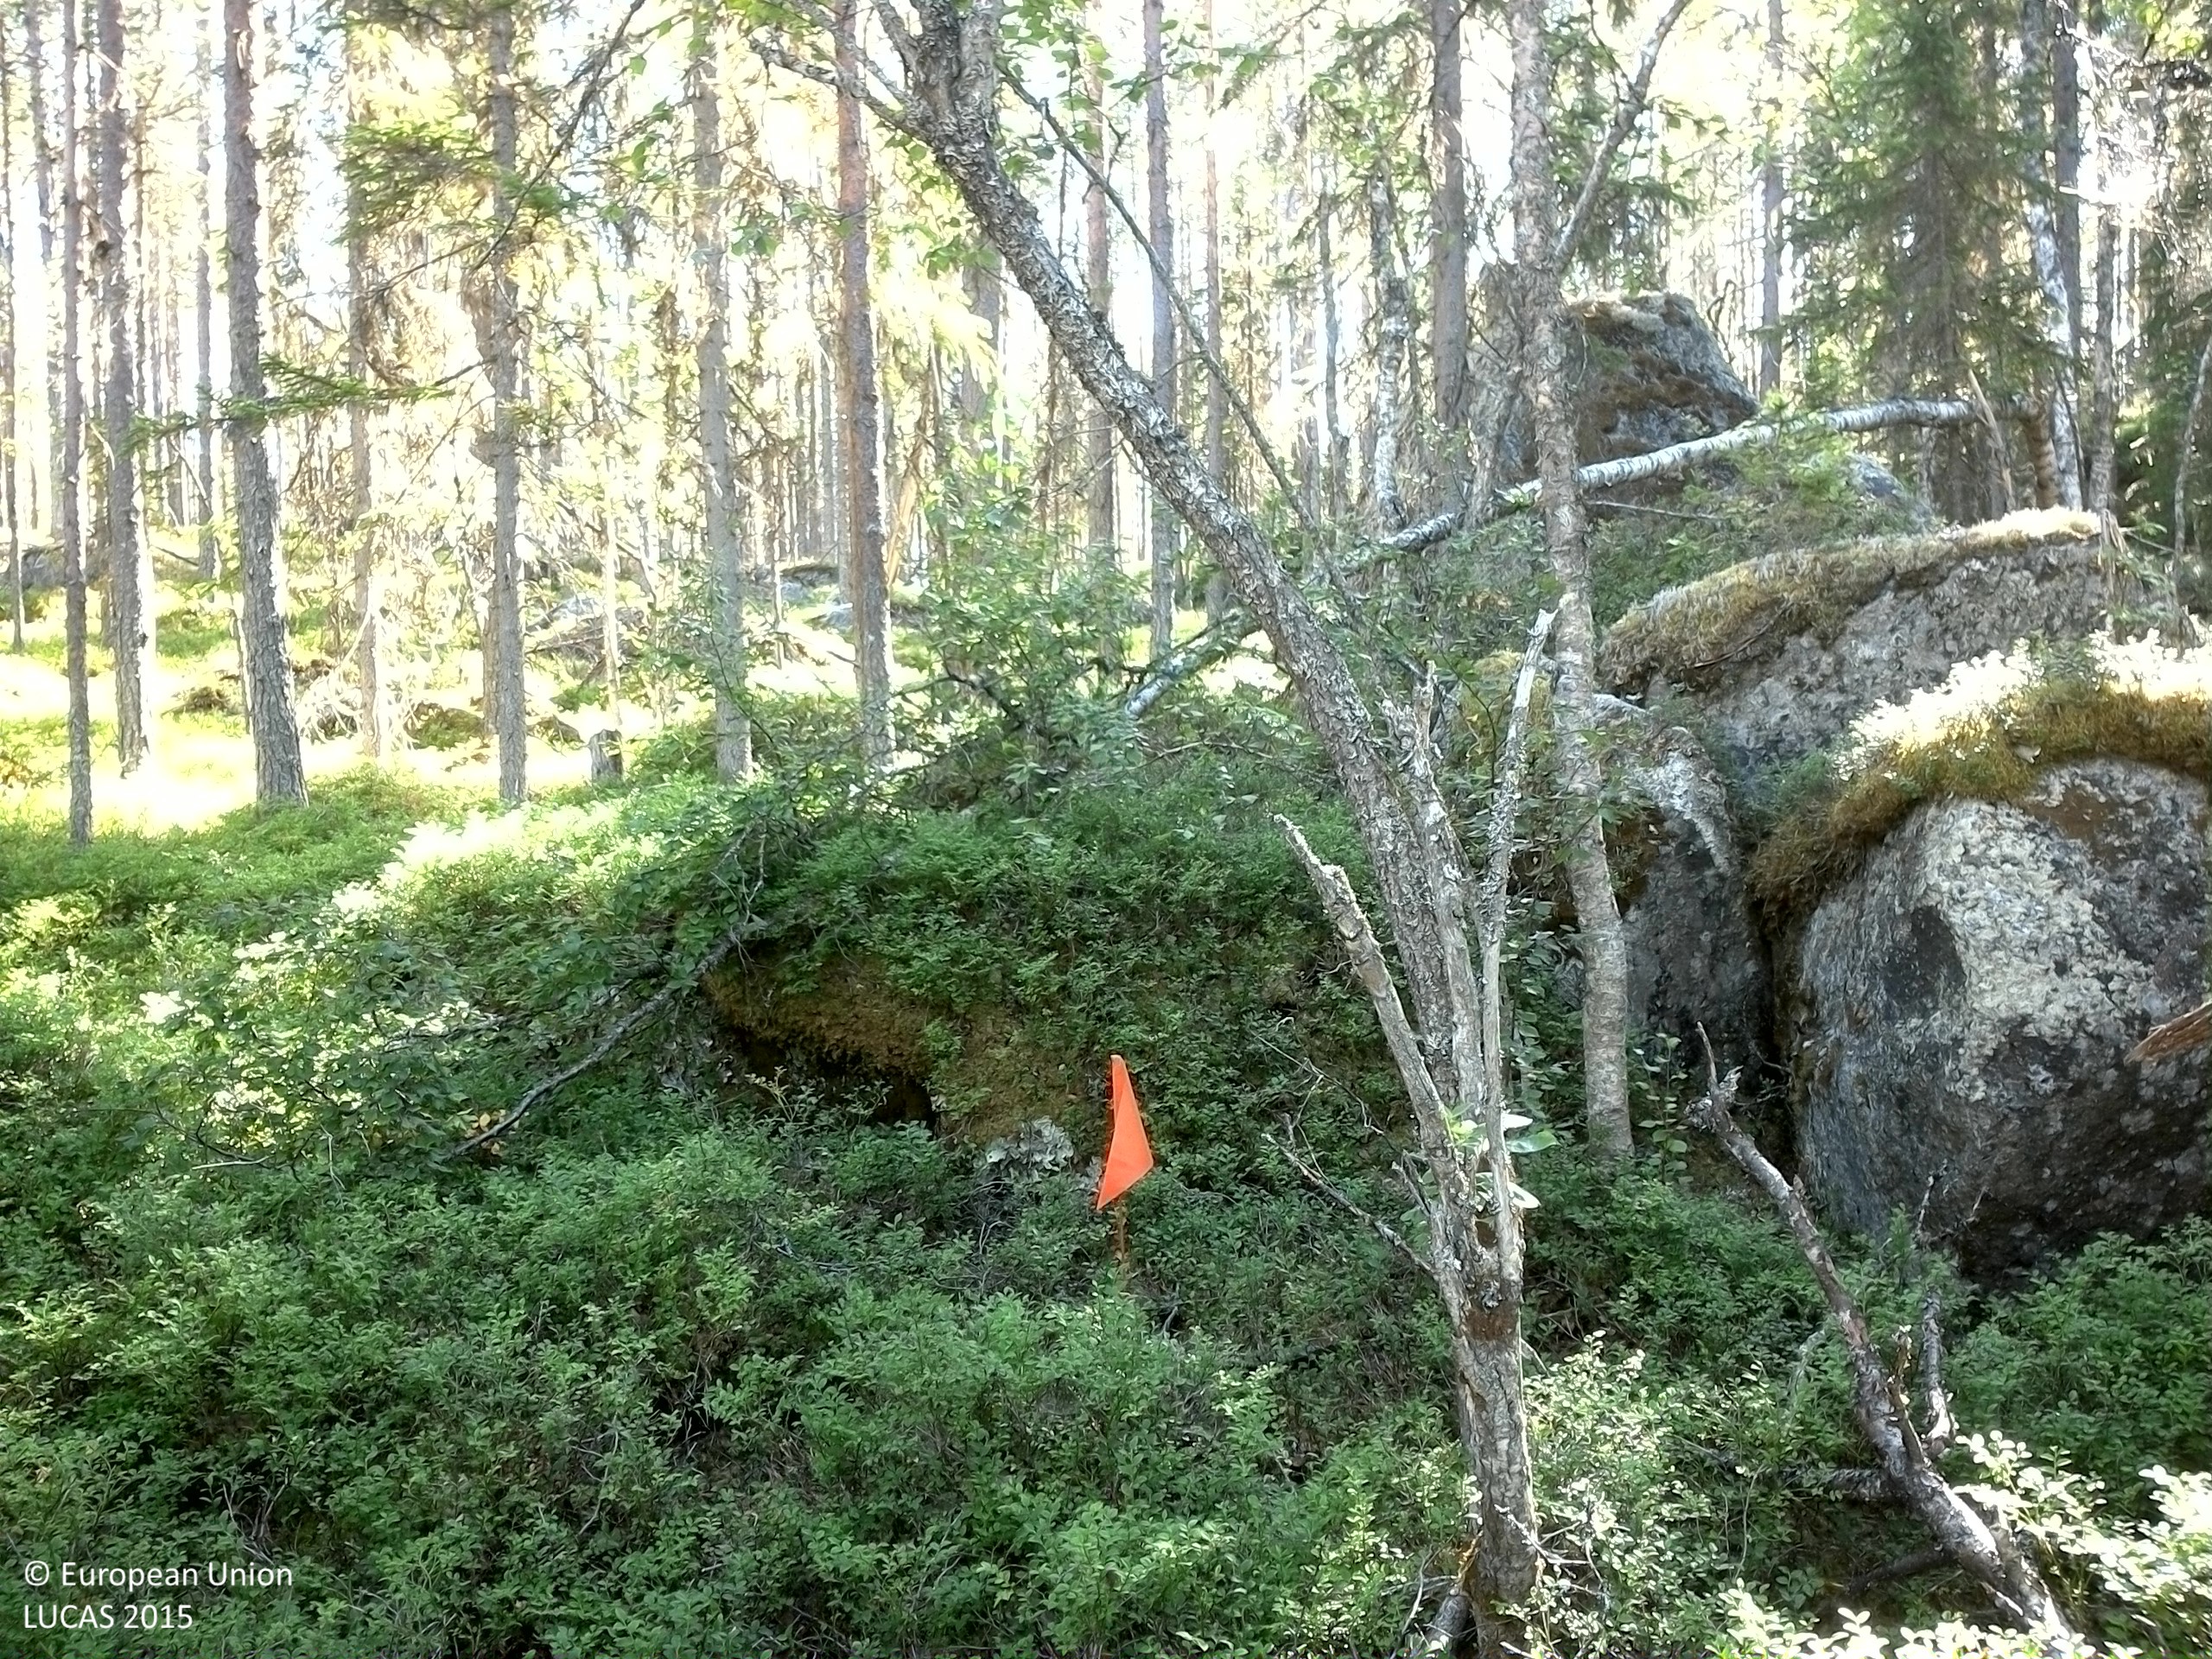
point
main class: Woodland
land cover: Pine dominated coniferous woodland
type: boreal forest
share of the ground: 50 - 75 %
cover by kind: coniferous forest trees 60 %, shrubs 30 %, broadleaved forest trees 10 %
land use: Forestry
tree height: > 5 m
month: August
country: SE
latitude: 63.7198
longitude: 17.7260
